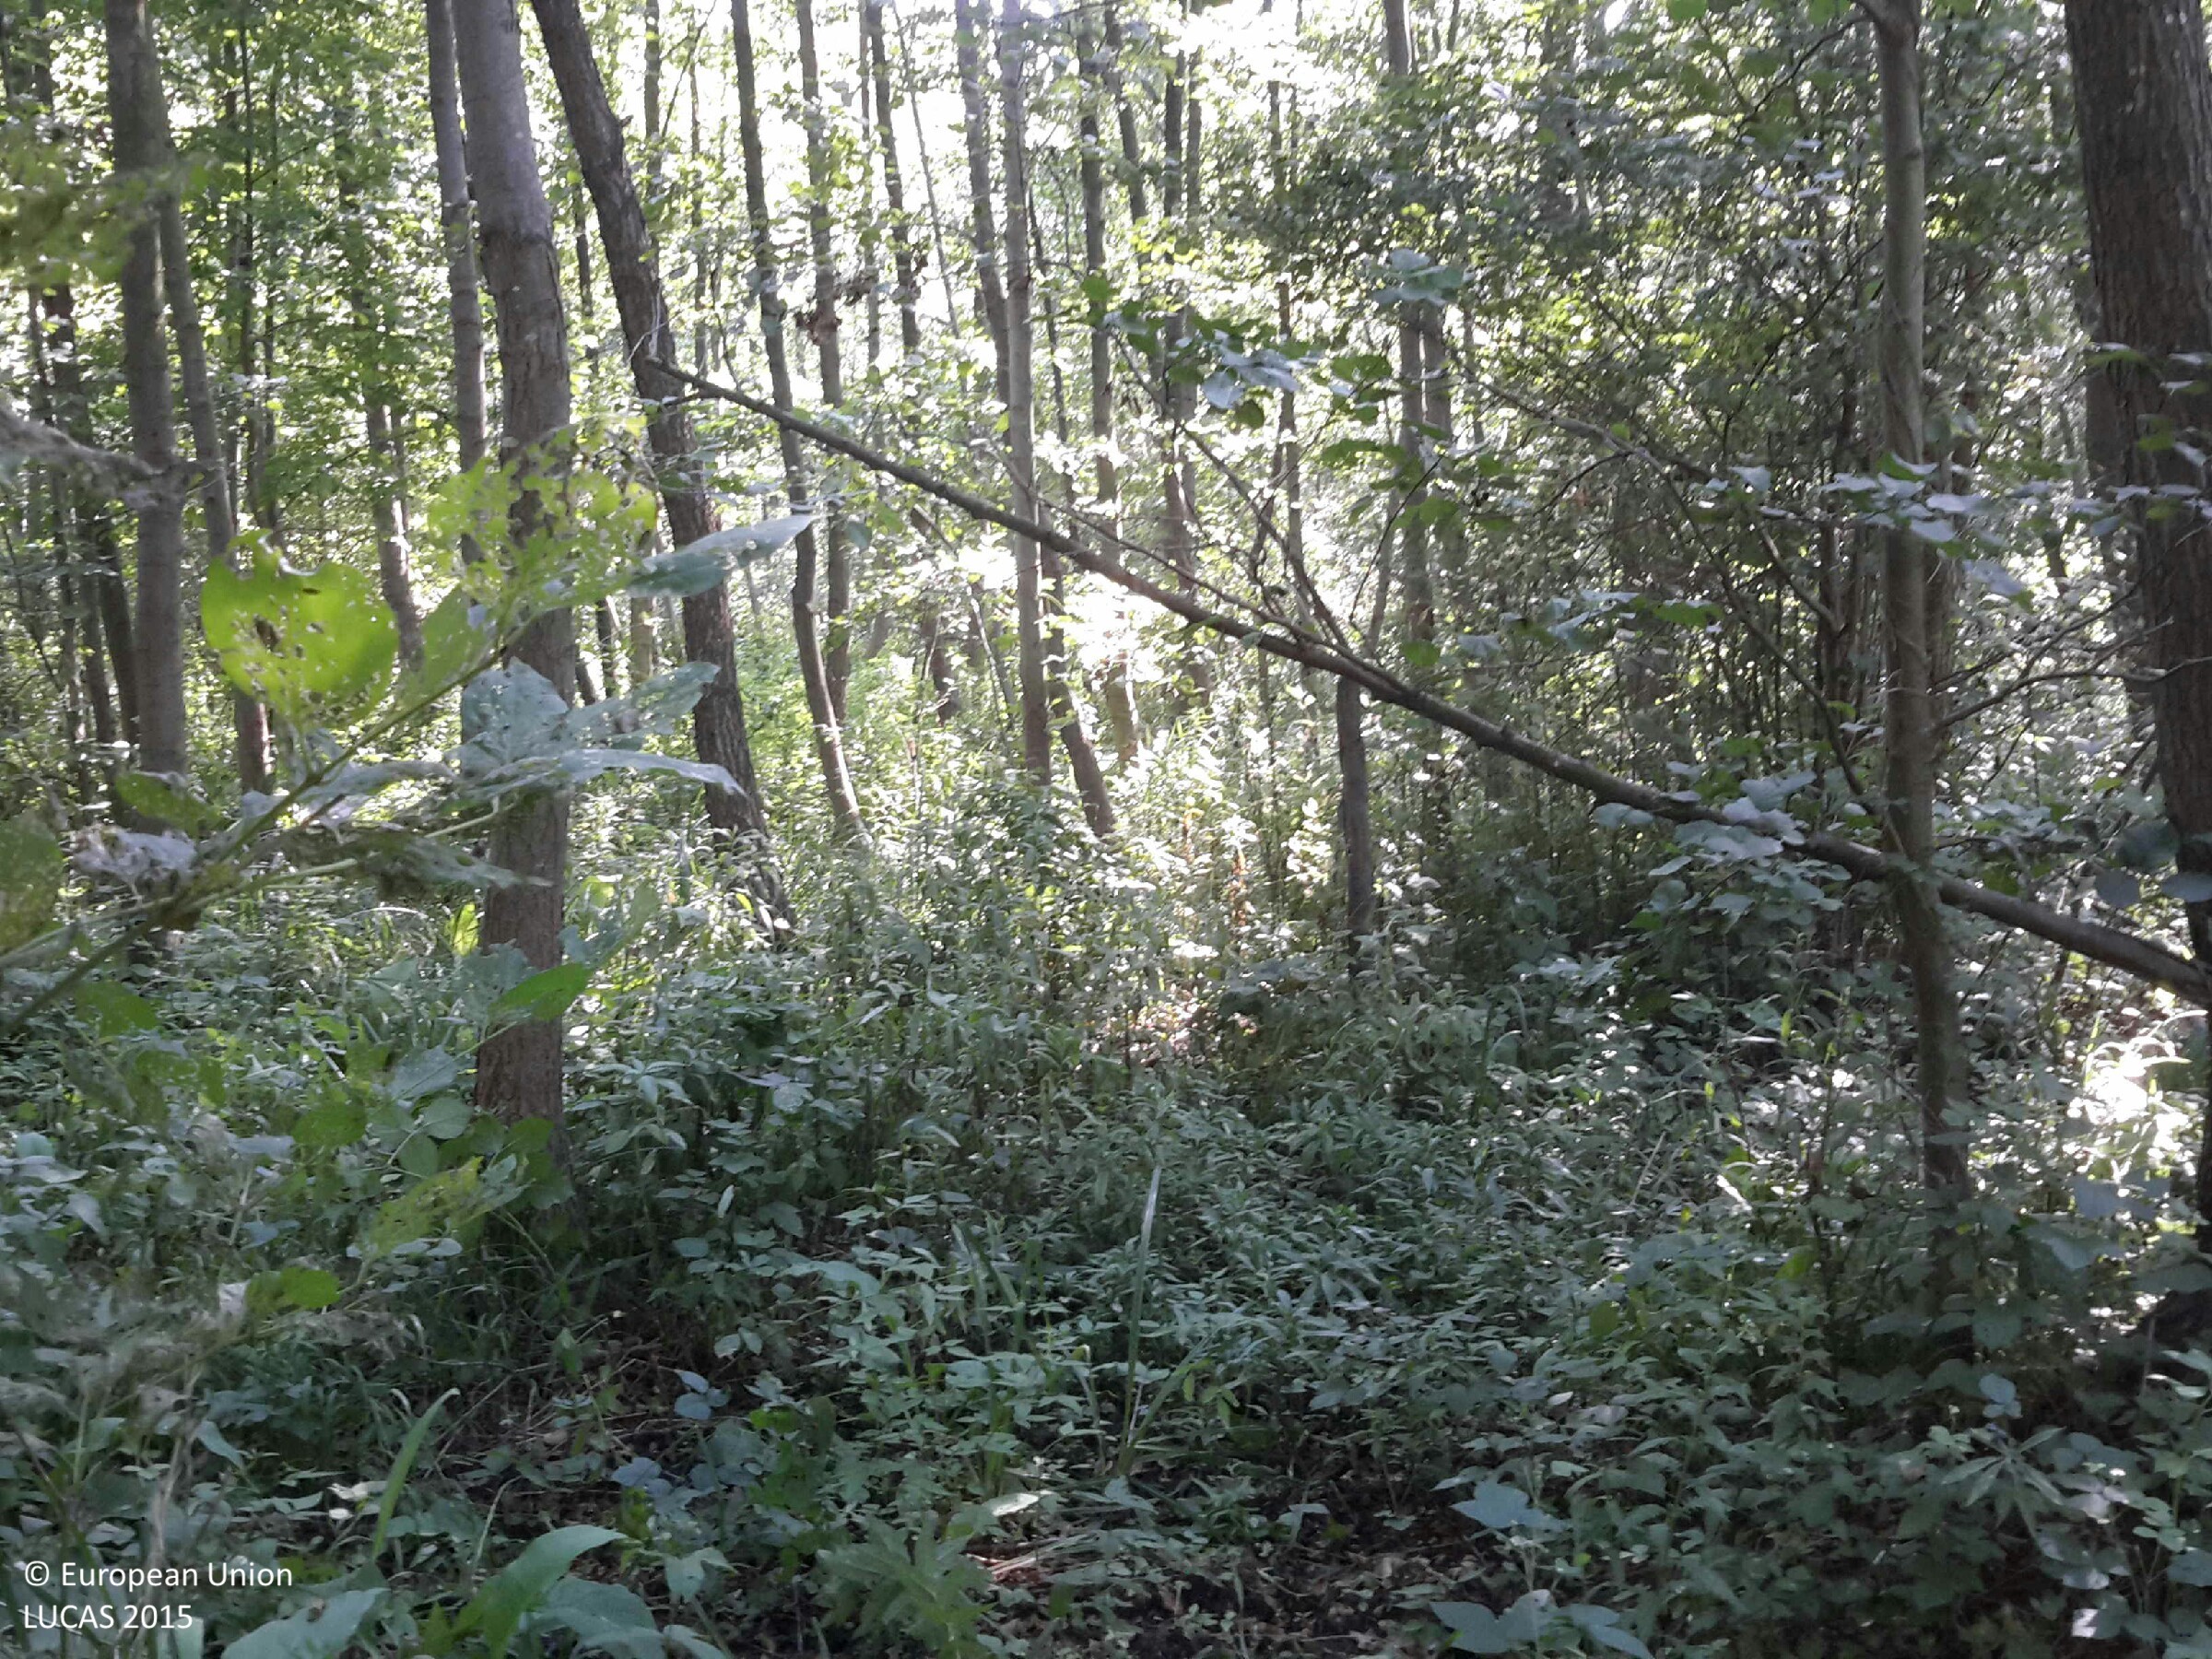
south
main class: Woodland
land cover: Broadleaved woodland
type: mesophytic deciduous forest
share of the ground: > 75 %
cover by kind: broadleaved forest trees 90 %, herbaceous plants 10 %
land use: Forestry
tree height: > 5 m
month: August
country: HU
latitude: 47.8017
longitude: 17.2845
